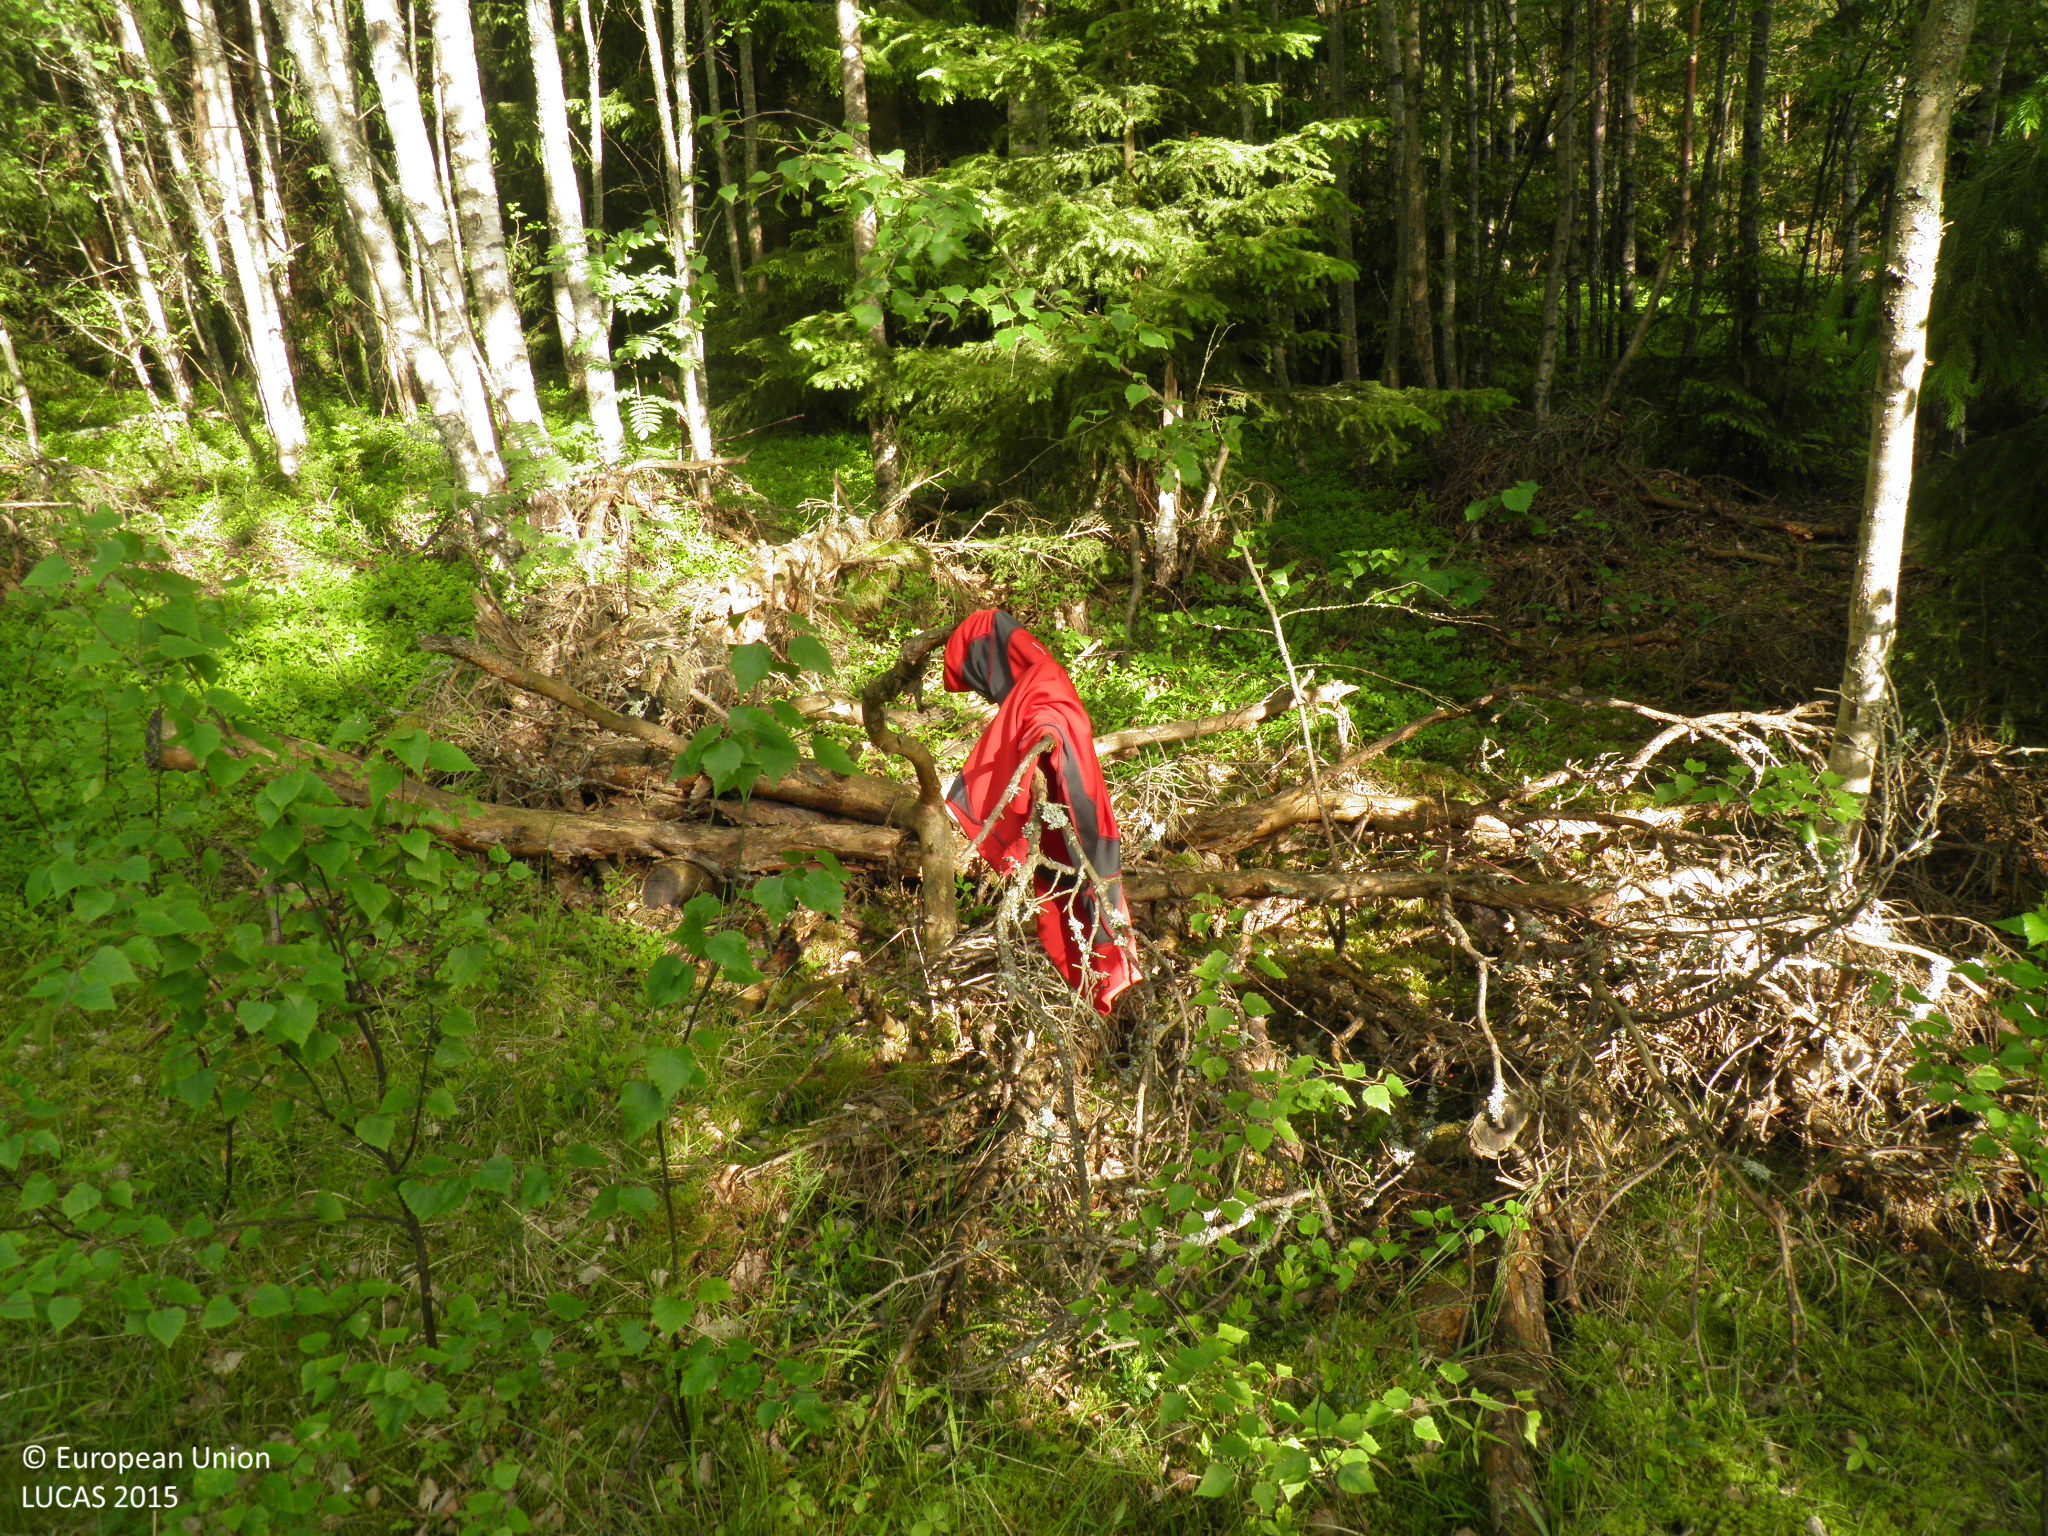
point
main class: Woodland
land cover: Spruce dominated mixed woodland
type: hemiboreal forest and nemoral coniferous forest and mixed broadleaved-coniferous forest
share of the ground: > 75 %
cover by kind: coniferous forest trees 40 %, broadleaved forest trees 40 %, shrubs 10 %, herbaceous plants 10 %
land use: Forestry
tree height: > 5 m
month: June
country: FI
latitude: 60.1907
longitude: 21.6198
